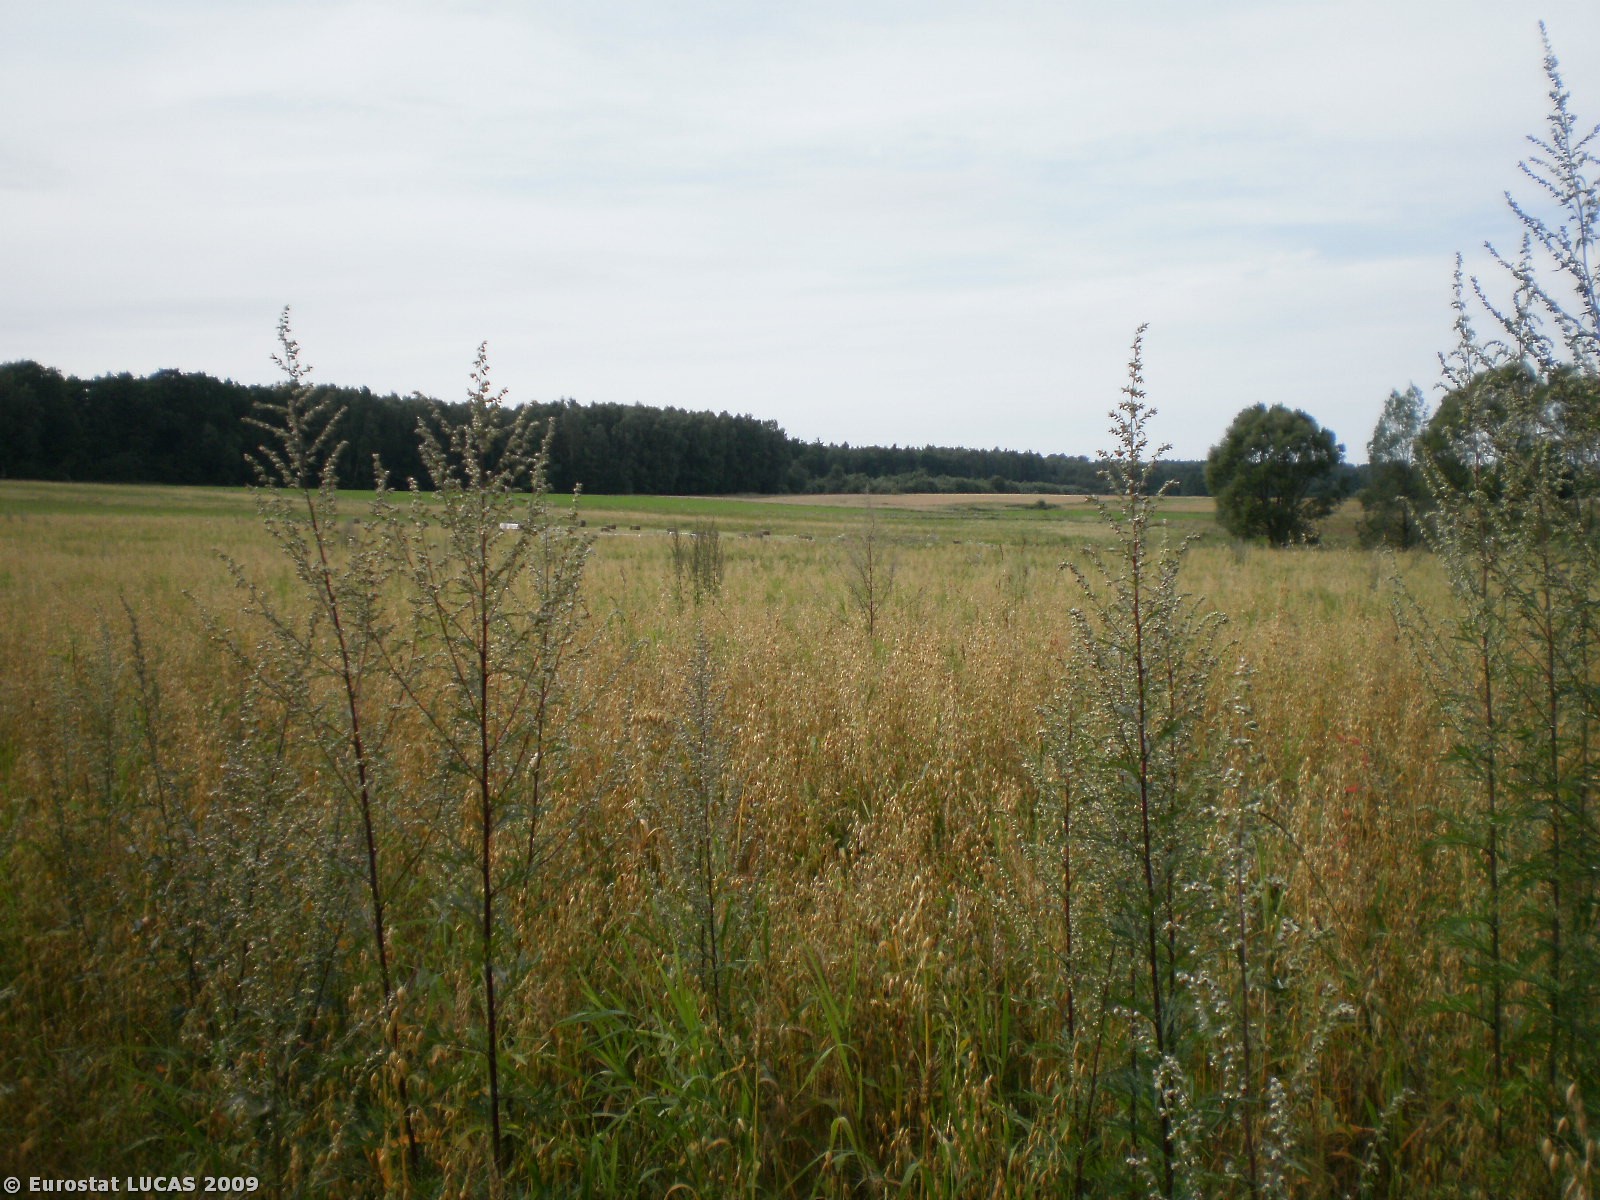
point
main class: Cropland
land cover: Mixed cereals for fodder
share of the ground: > 75 %
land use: Agriculture (excluding fallow land and kitchen gardens)
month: August
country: PL
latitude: 54.2651
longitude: 19.6537
